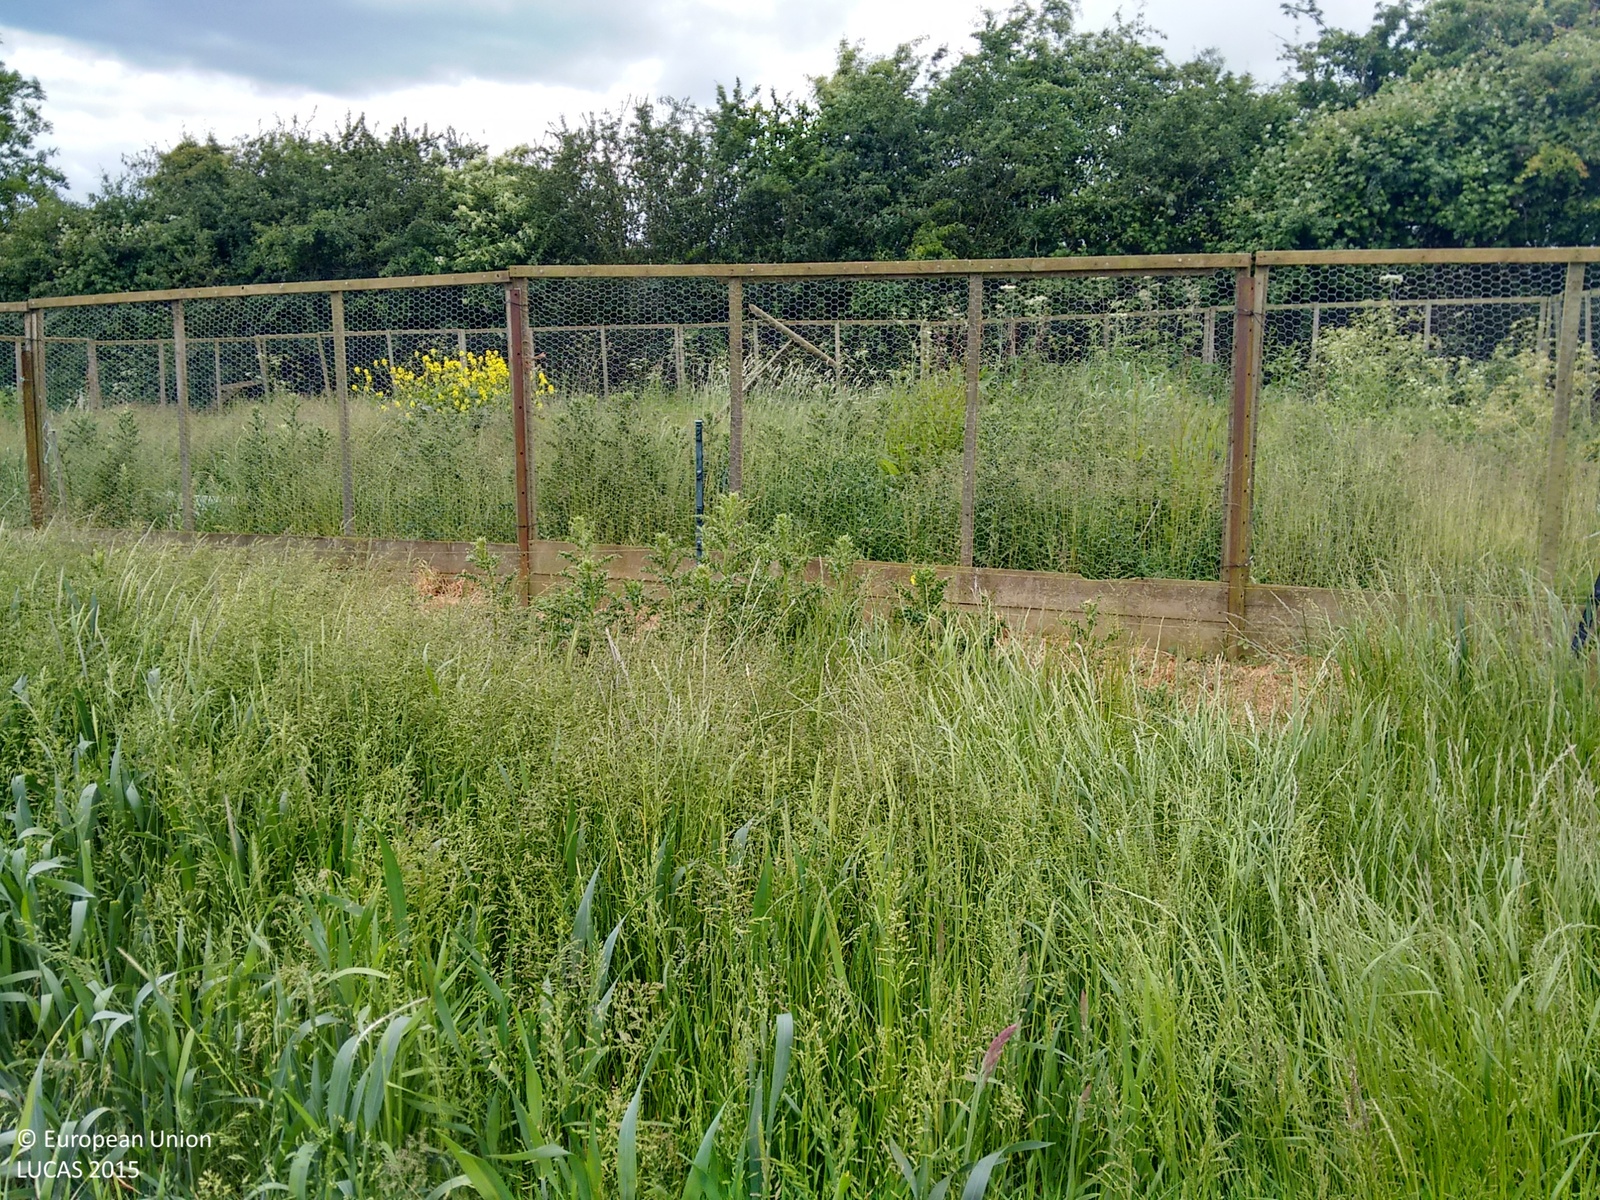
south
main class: Cropland
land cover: Common wheat
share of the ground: > 75 %
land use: Agriculture (excluding fallow land and kitchen gardens)
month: June
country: GB
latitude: 52.1036
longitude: -1.7193
